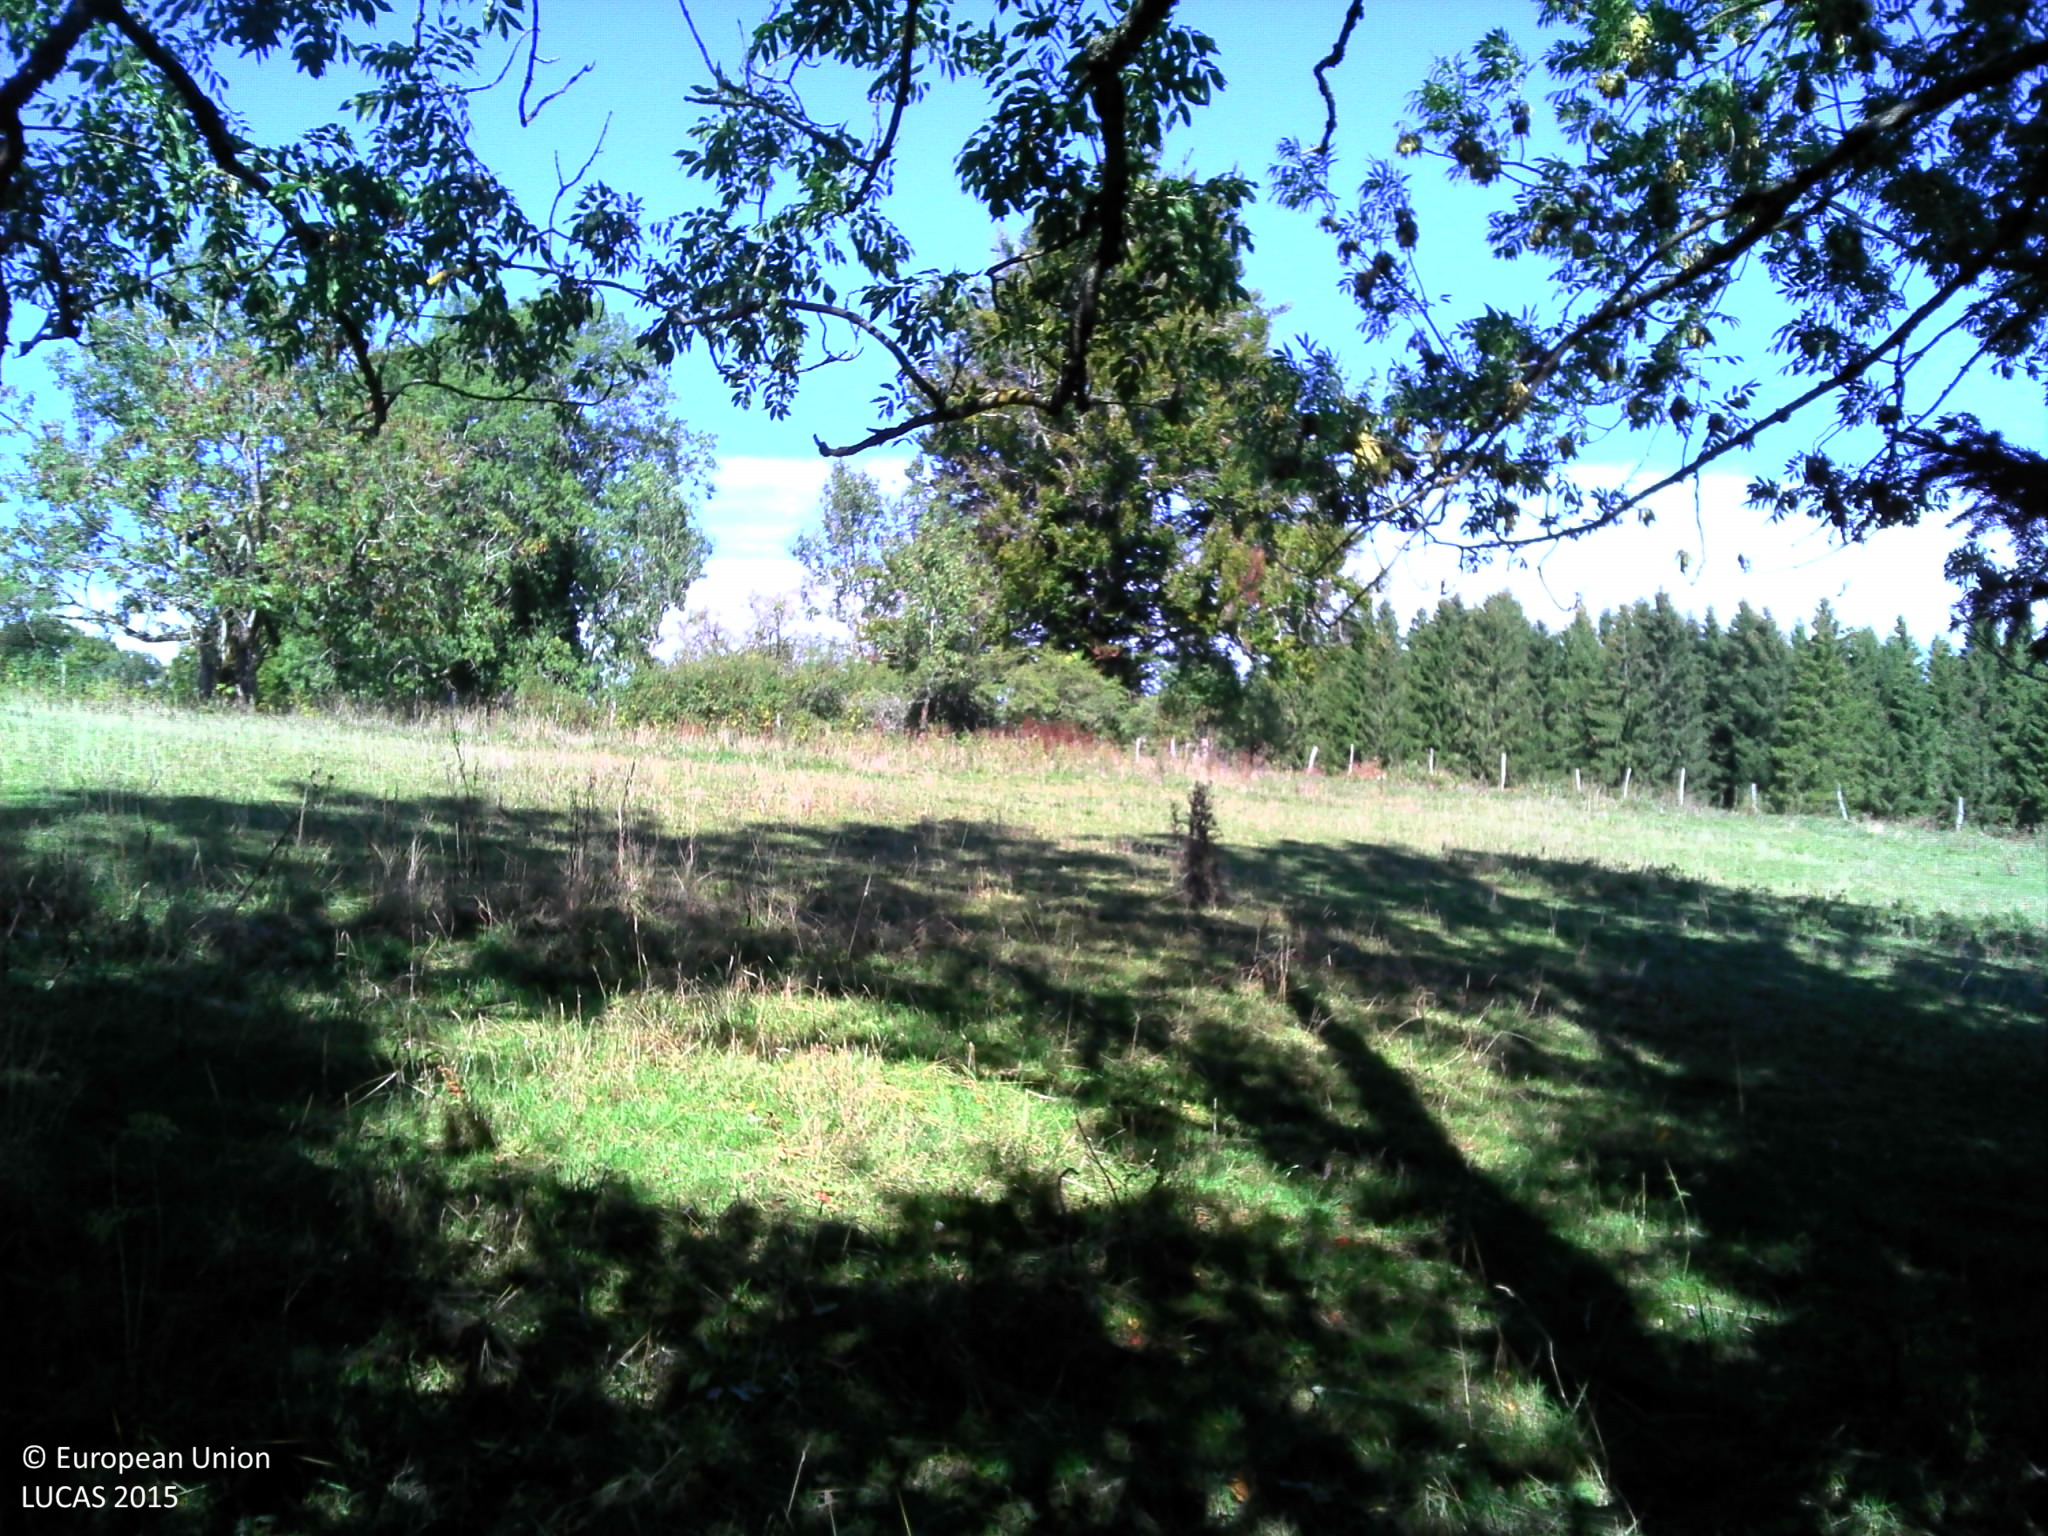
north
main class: Grassland
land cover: Grassland without tree/shrub cover
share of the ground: > 75 %
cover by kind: herbaceous plants 100 %
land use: Agriculture (excluding fallow land and kitchen gardens)
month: September
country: FR
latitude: 47.2238
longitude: 6.8457
